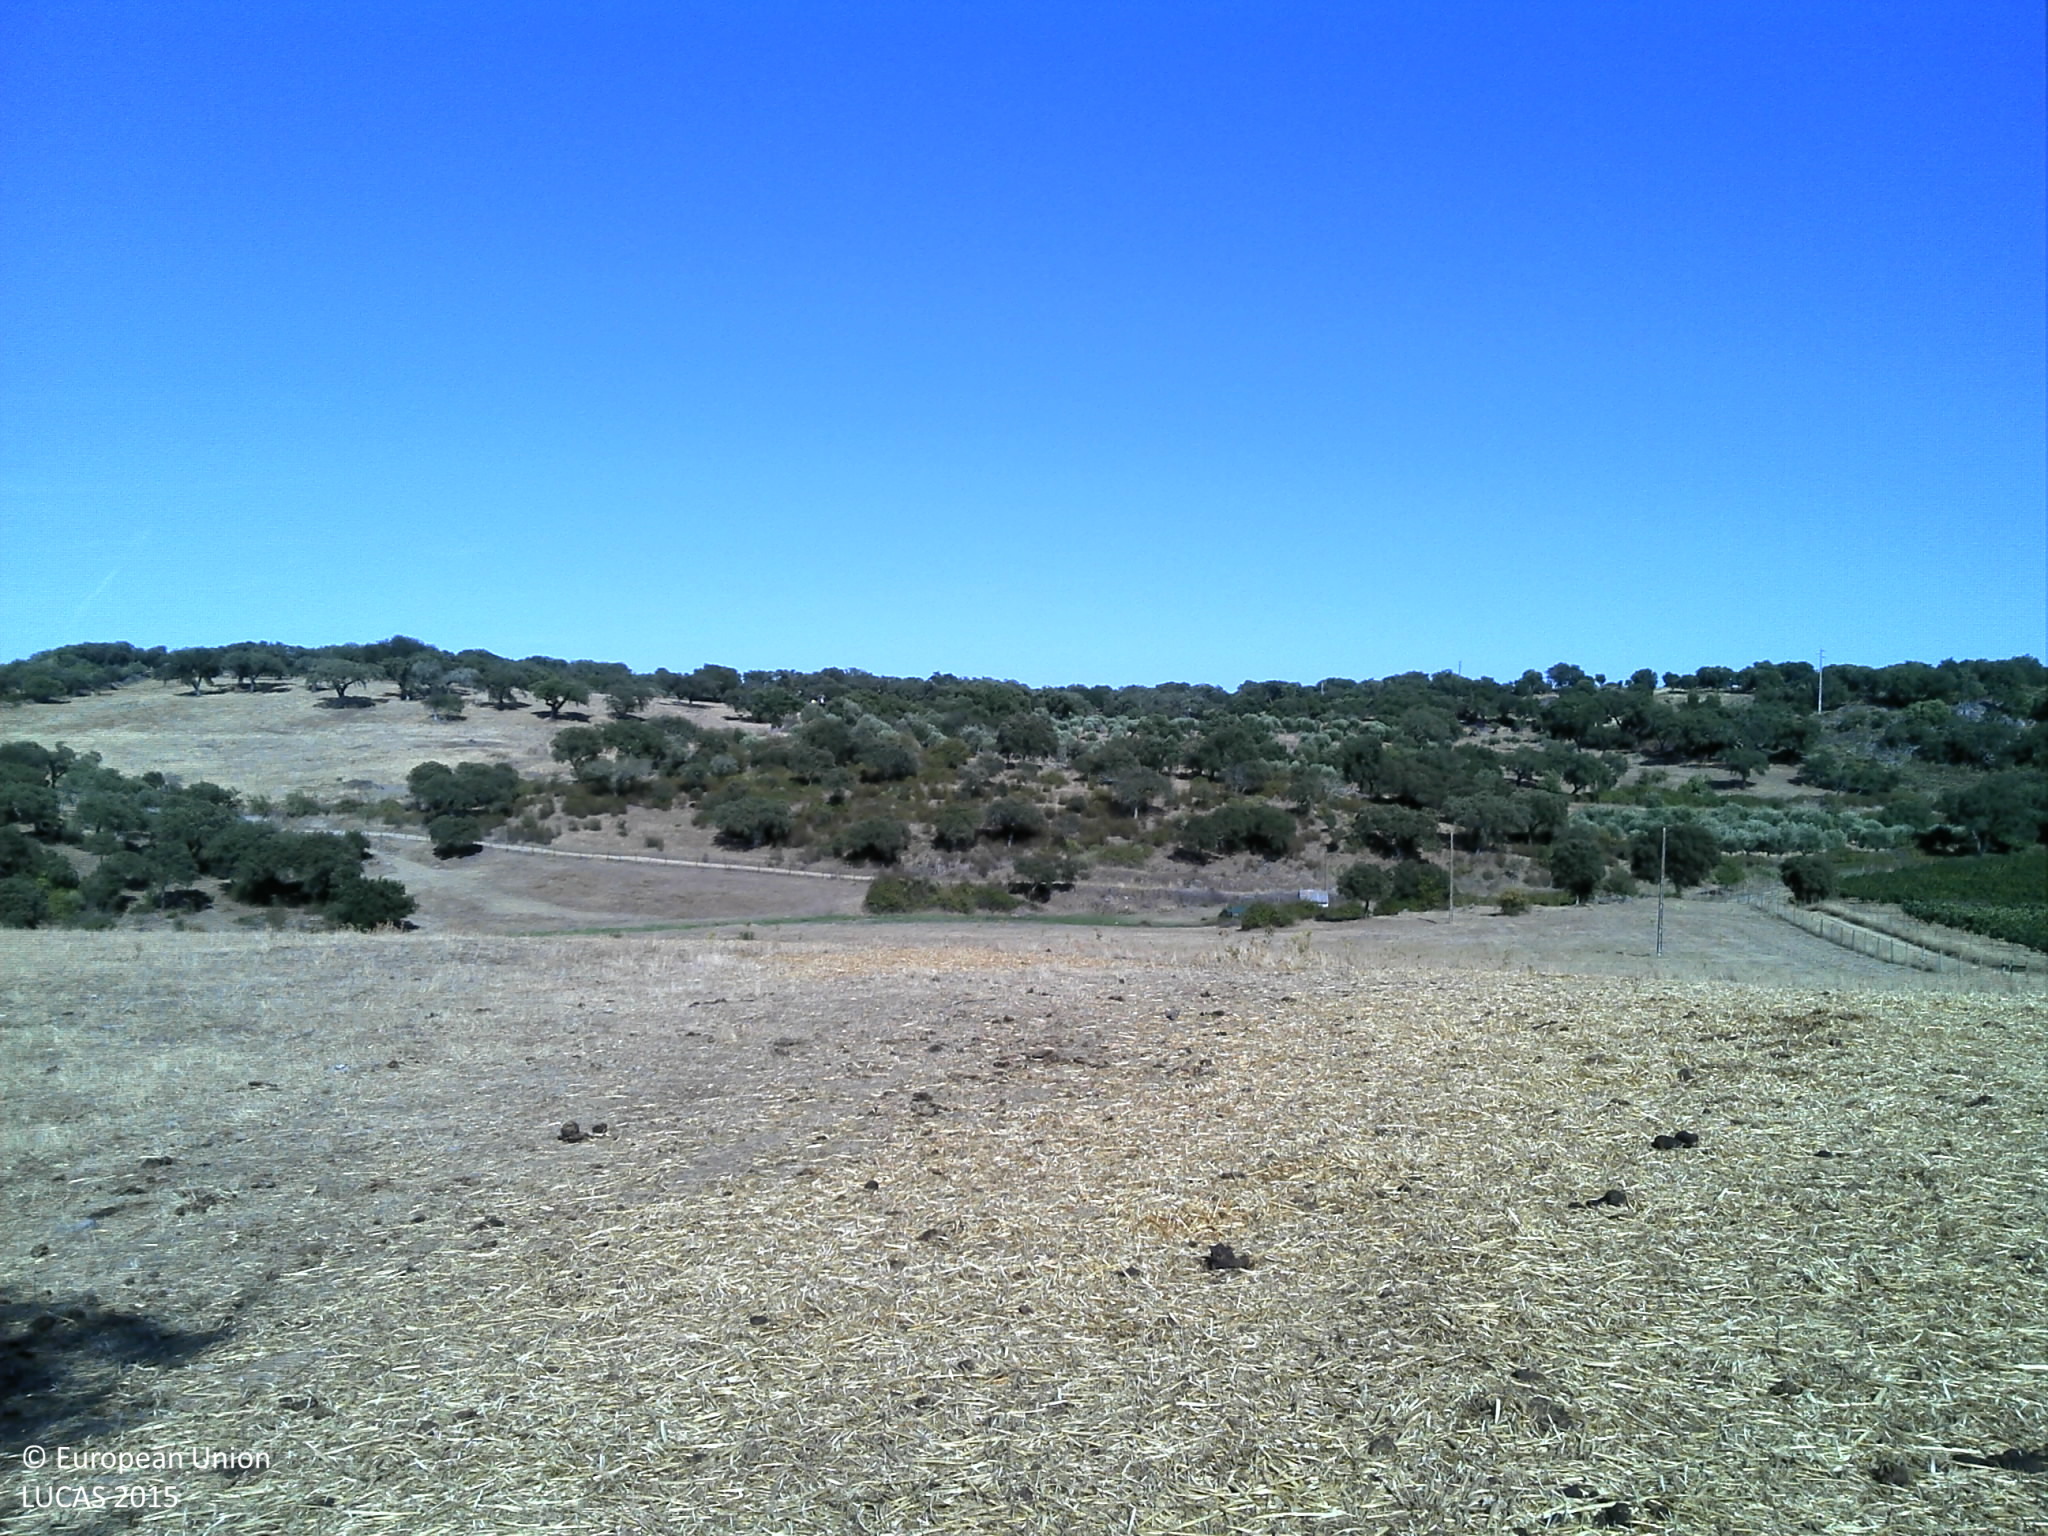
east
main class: Woodland
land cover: Broadleaved woodland
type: broadleaved evergreen forest
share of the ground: 10 - 25 %
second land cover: Grassland without tree/shrub cover
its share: 10 - 25 %
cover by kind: unconsolidated bare surface 75 %, herbaceous plants 15 %, broadleaved forest trees 10 %
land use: Forestry
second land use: Agriculture (excluding fallow land and kitchen gardens)
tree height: > 5 m
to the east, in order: Broadleaved woodland; Grassland without tree/shrub cover; Rivers and streams; Shrubland without tree cover; Fences; Grass margins; Tracks; Grass margins; Fences; Broadleaved woodland
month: August
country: PT
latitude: 39.5198
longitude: -7.5550
